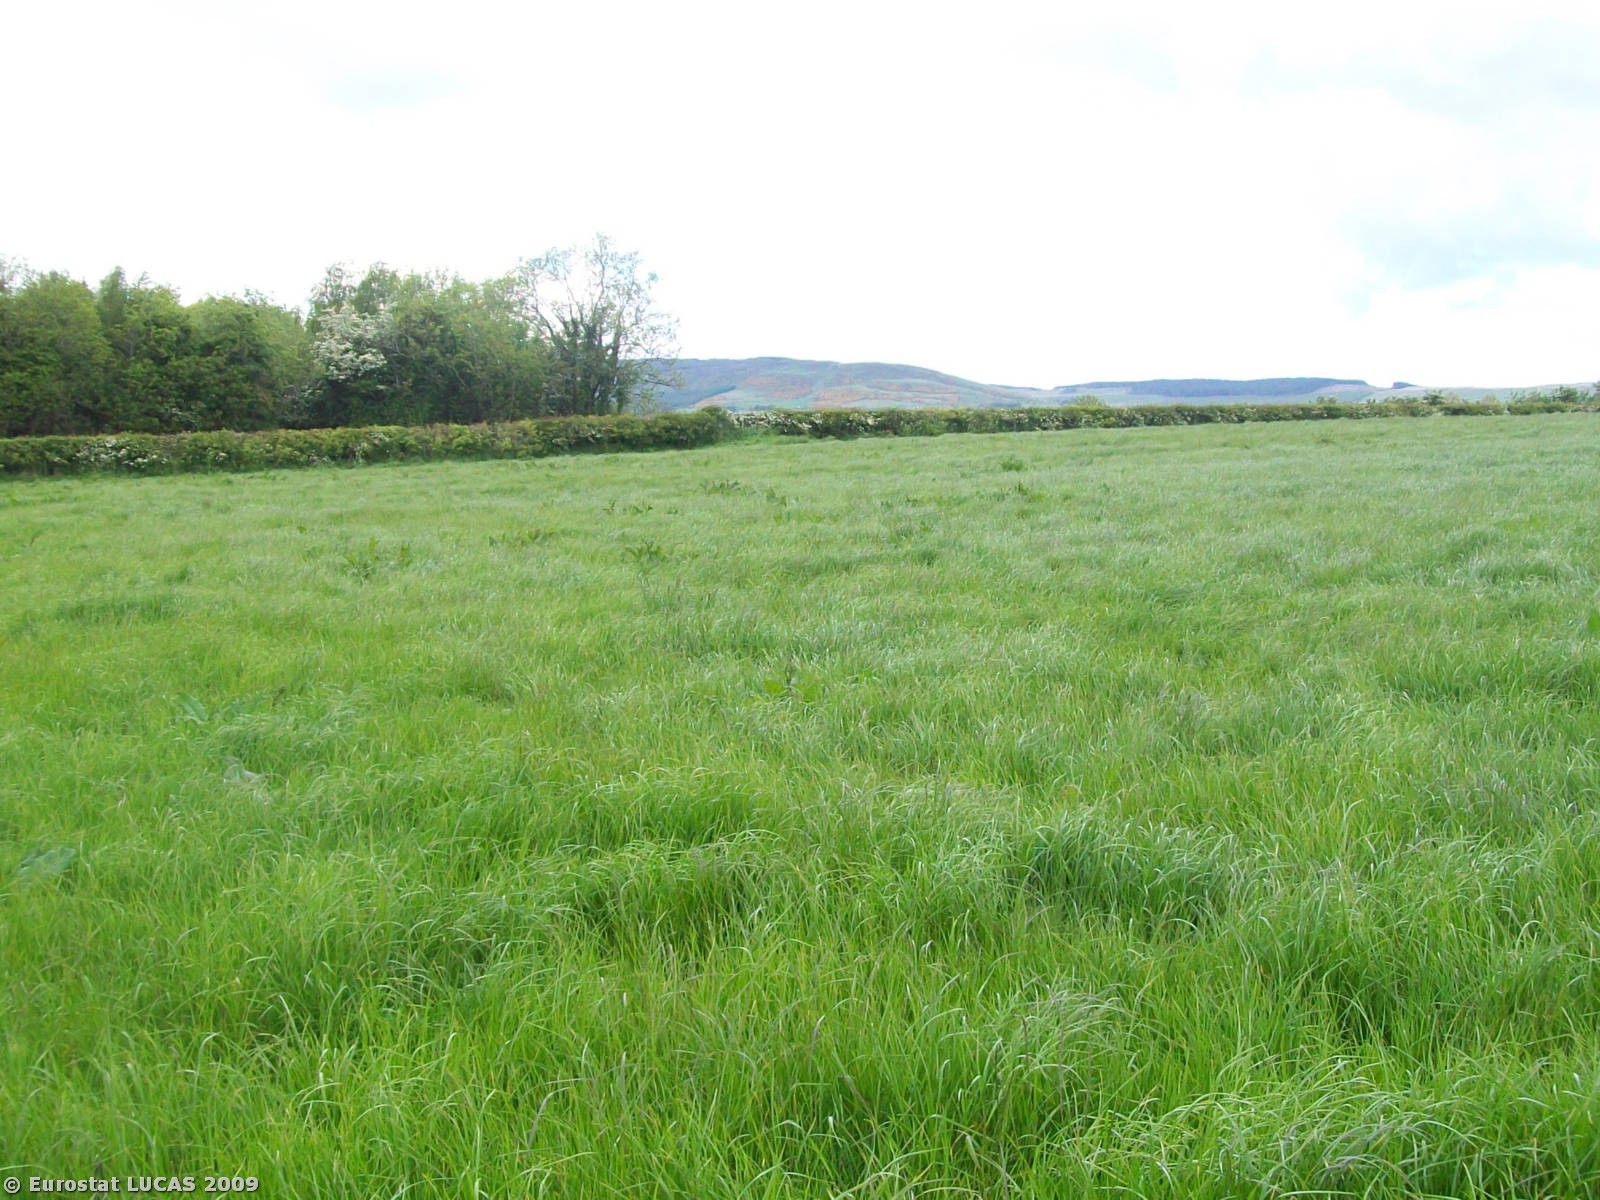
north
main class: Grassland
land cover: Grassland without tree/shrub cover
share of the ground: > 75 %
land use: Agriculture (excluding fallow land and kitchen gardens)
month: May
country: GB
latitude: 55.0541
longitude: -6.9001
